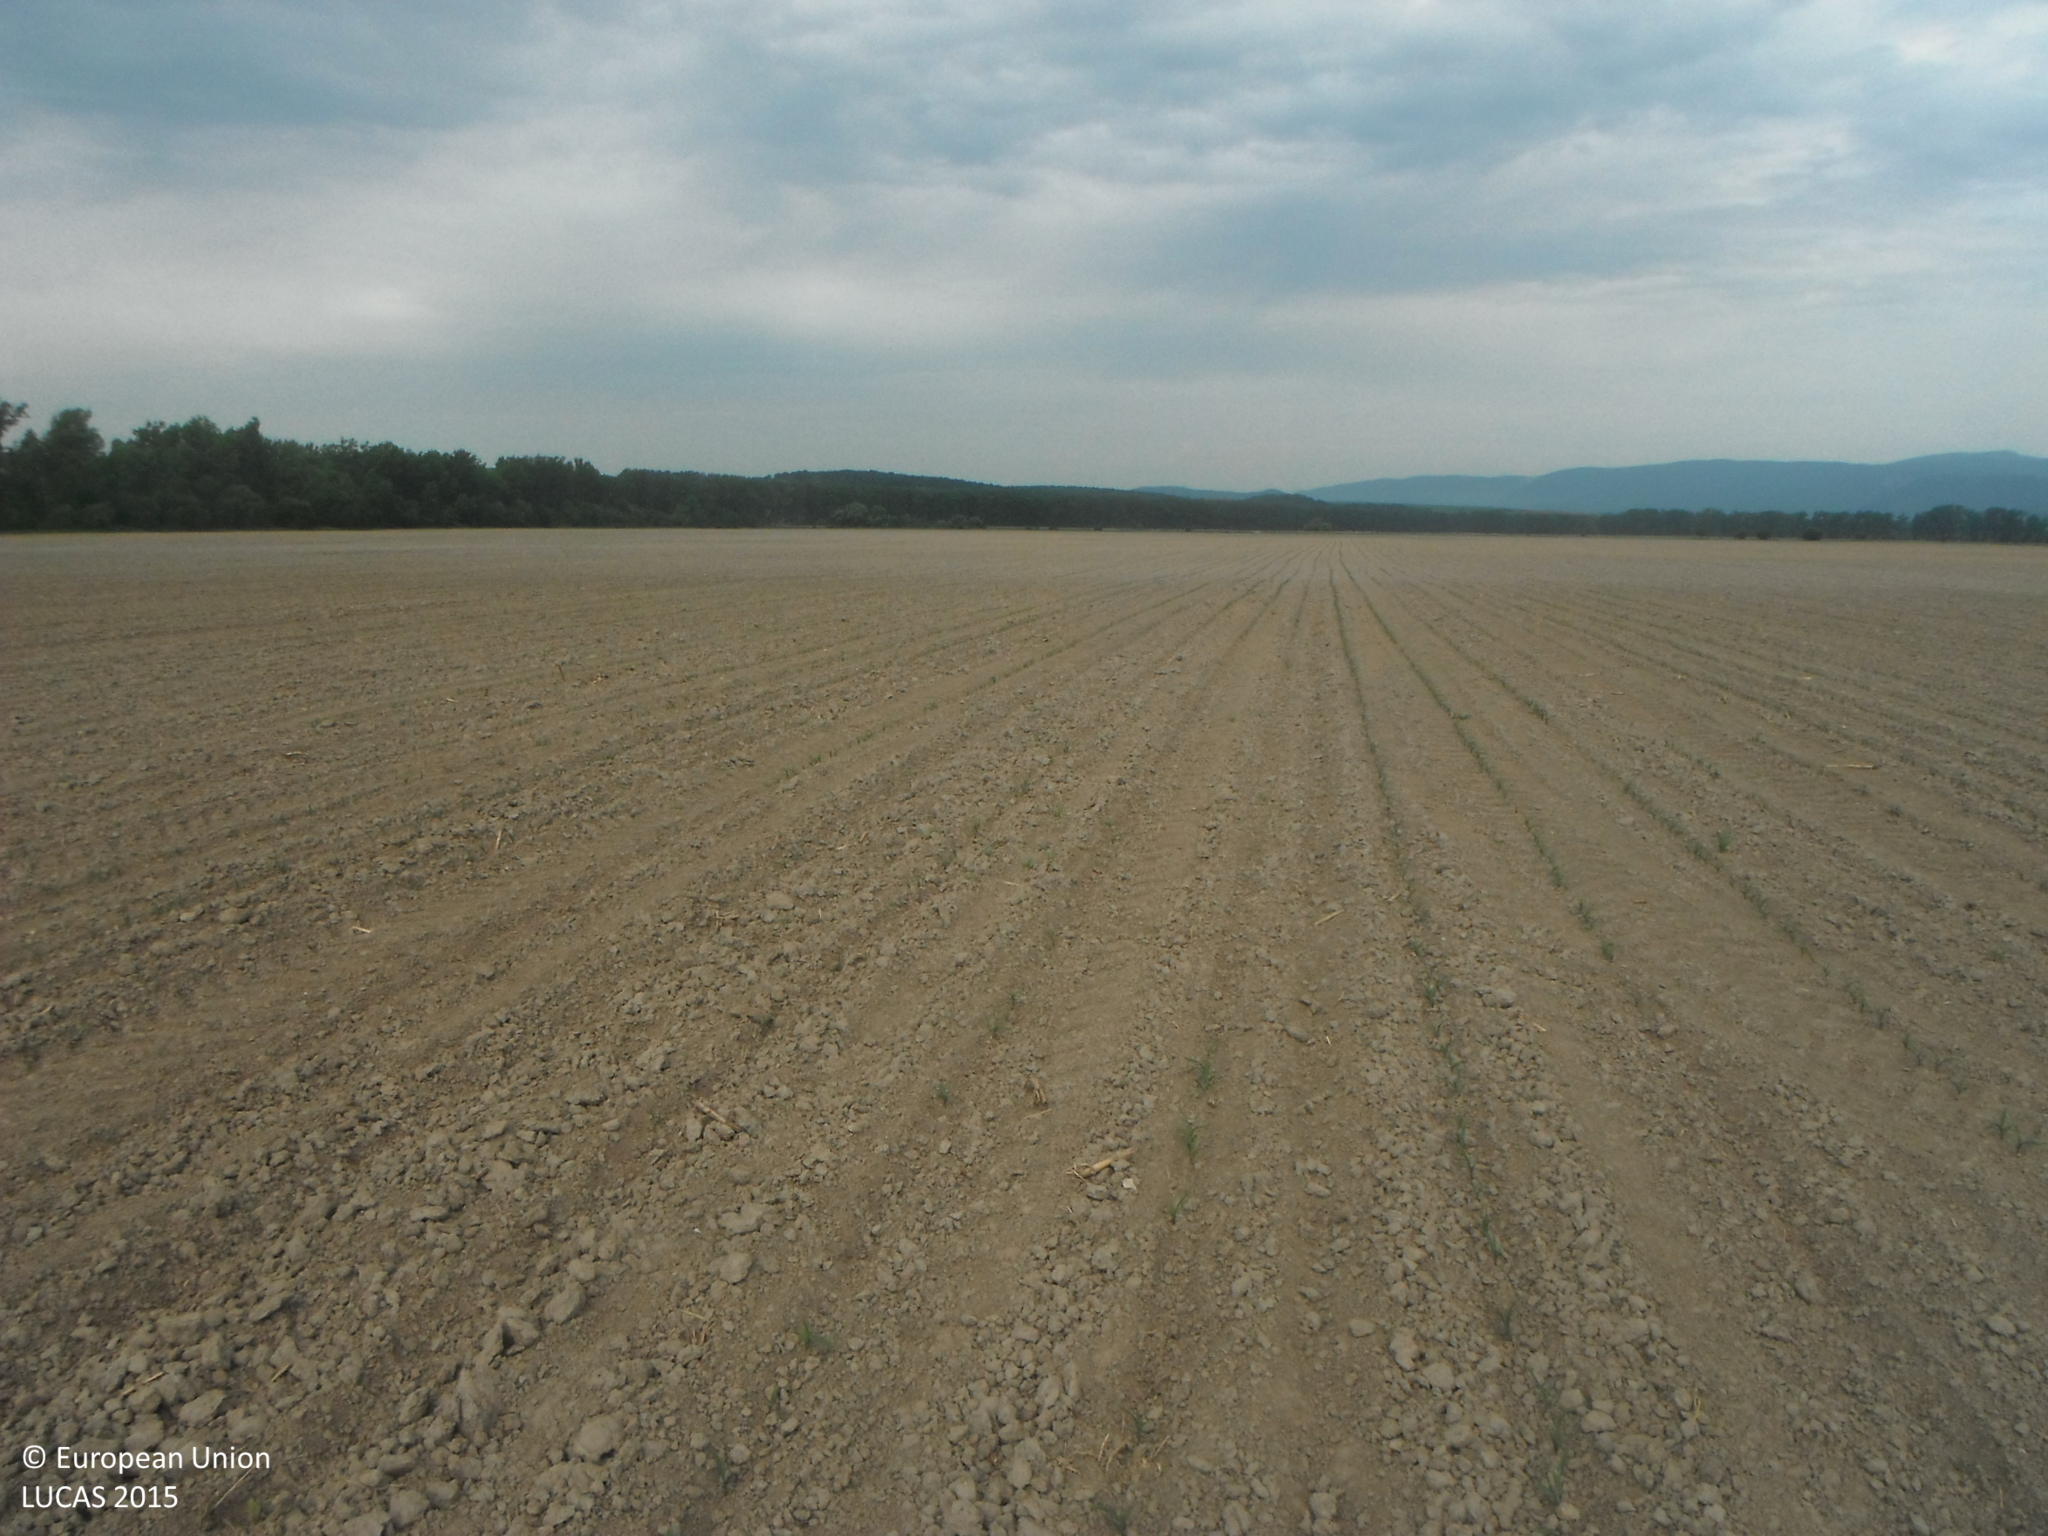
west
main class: Cropland
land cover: Maize
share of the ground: < 10 %
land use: Agriculture (excluding fallow land and kitchen gardens)
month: May
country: SK
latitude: 48.5634
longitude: 20.9759
